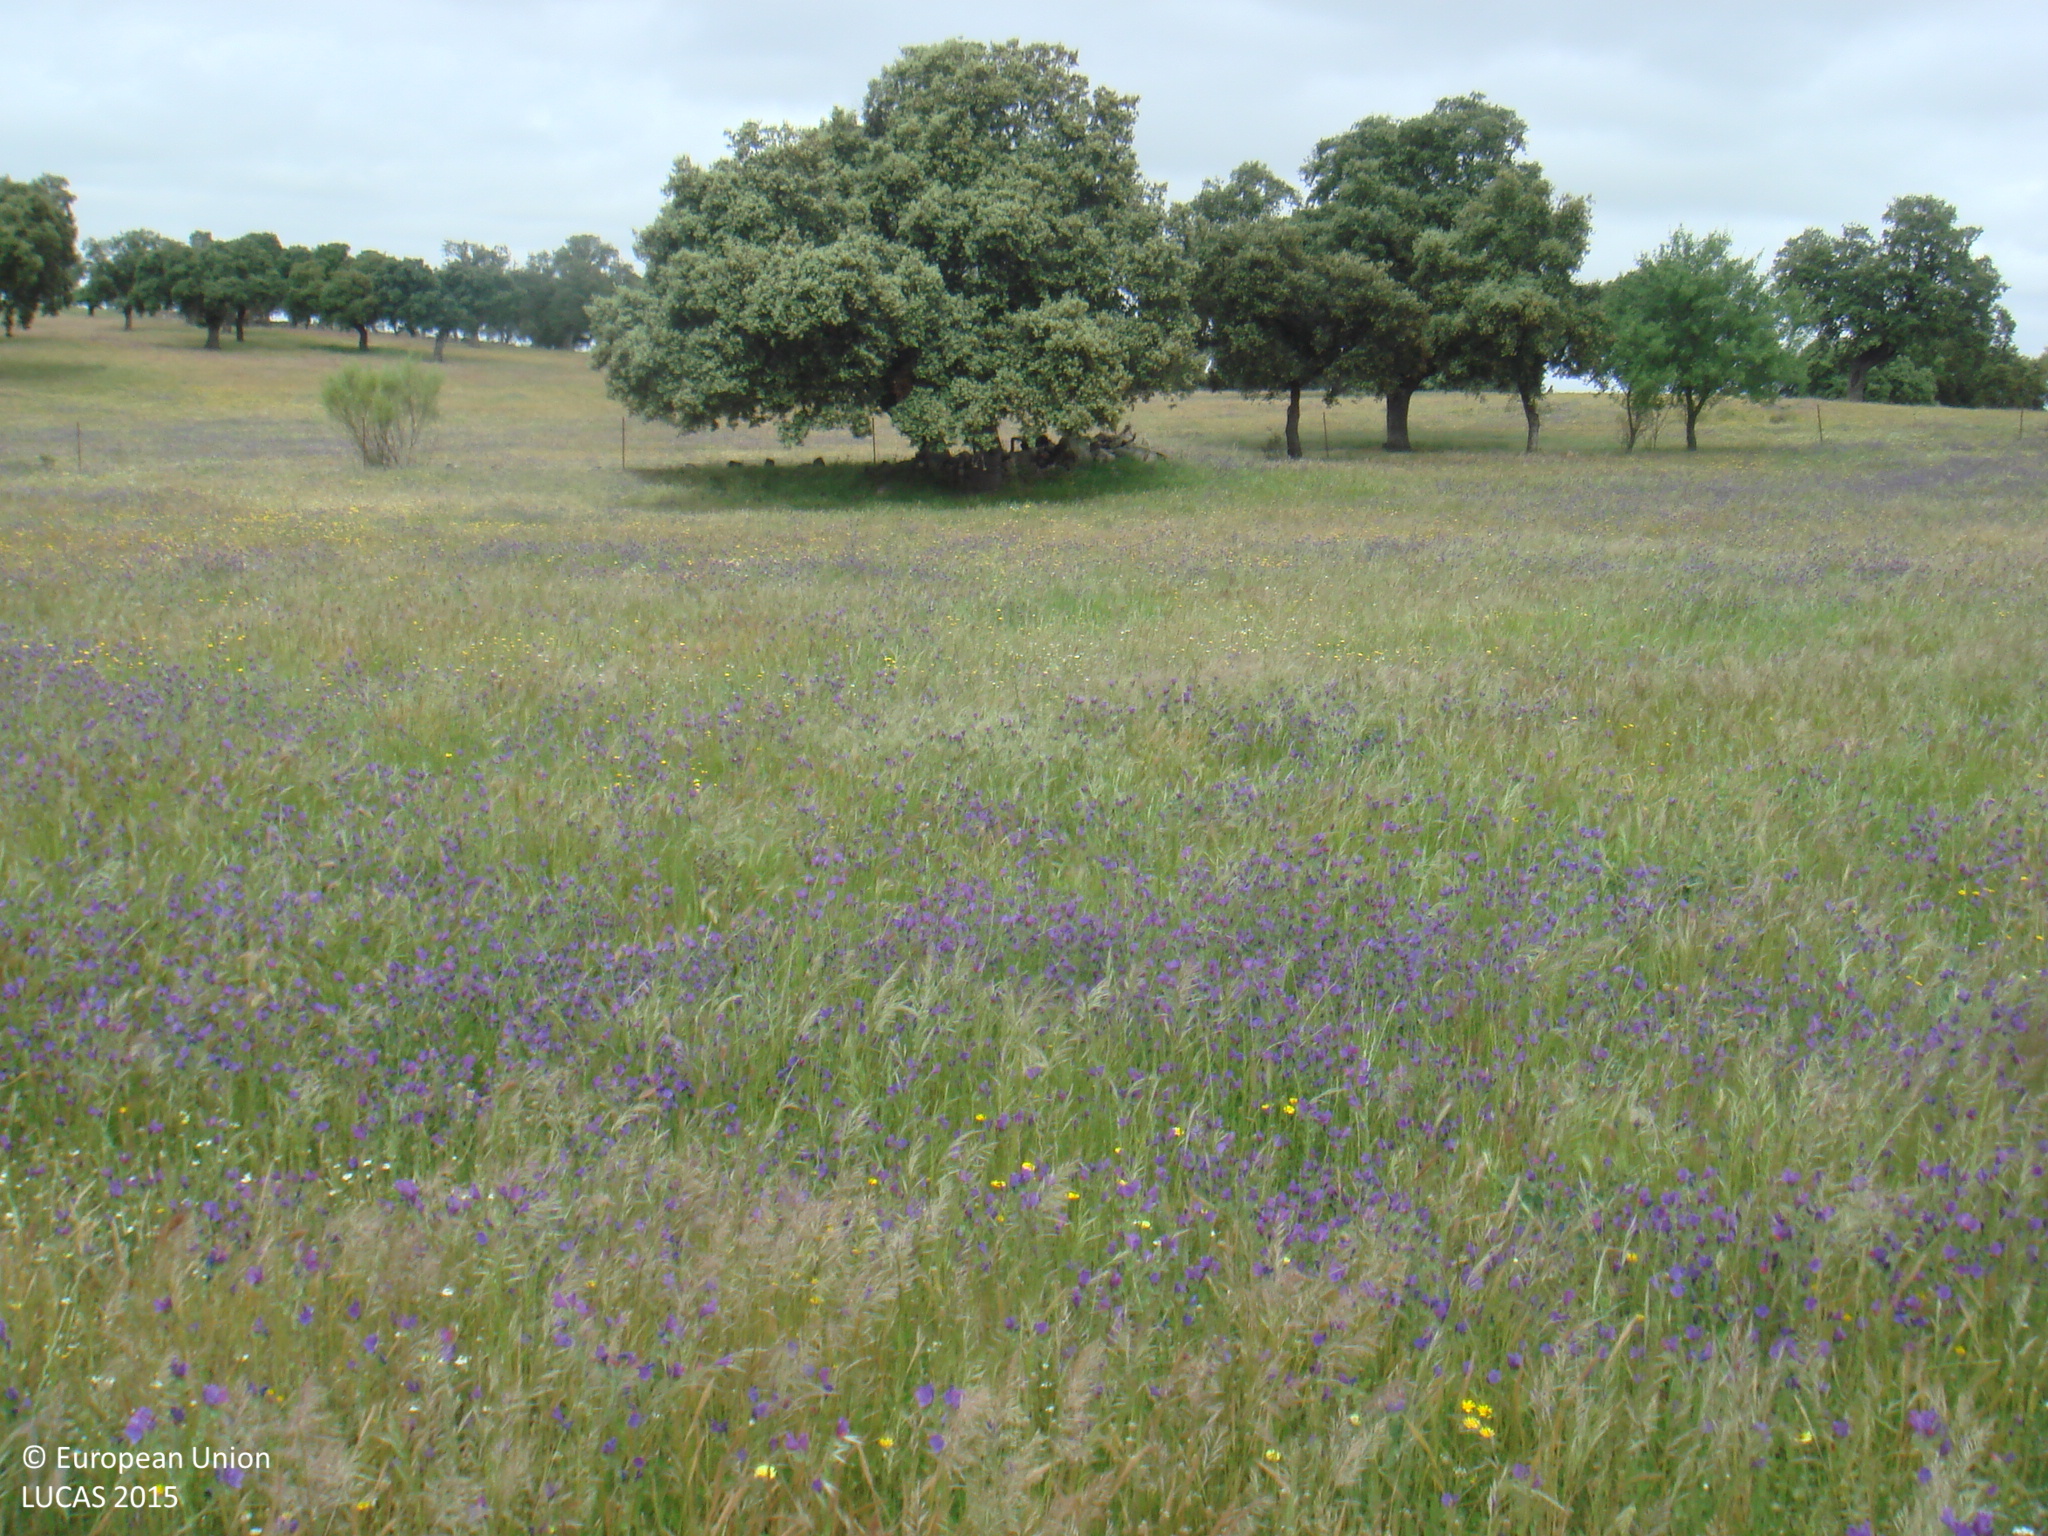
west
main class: Grassland
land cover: Grassland without tree/shrub cover
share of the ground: > 75 %
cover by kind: herbaceous plants 100 %
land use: Agriculture (excluding fallow land and kitchen gardens)
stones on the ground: < 10 %
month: May
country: ES
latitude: 38.4091
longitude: -4.7614
